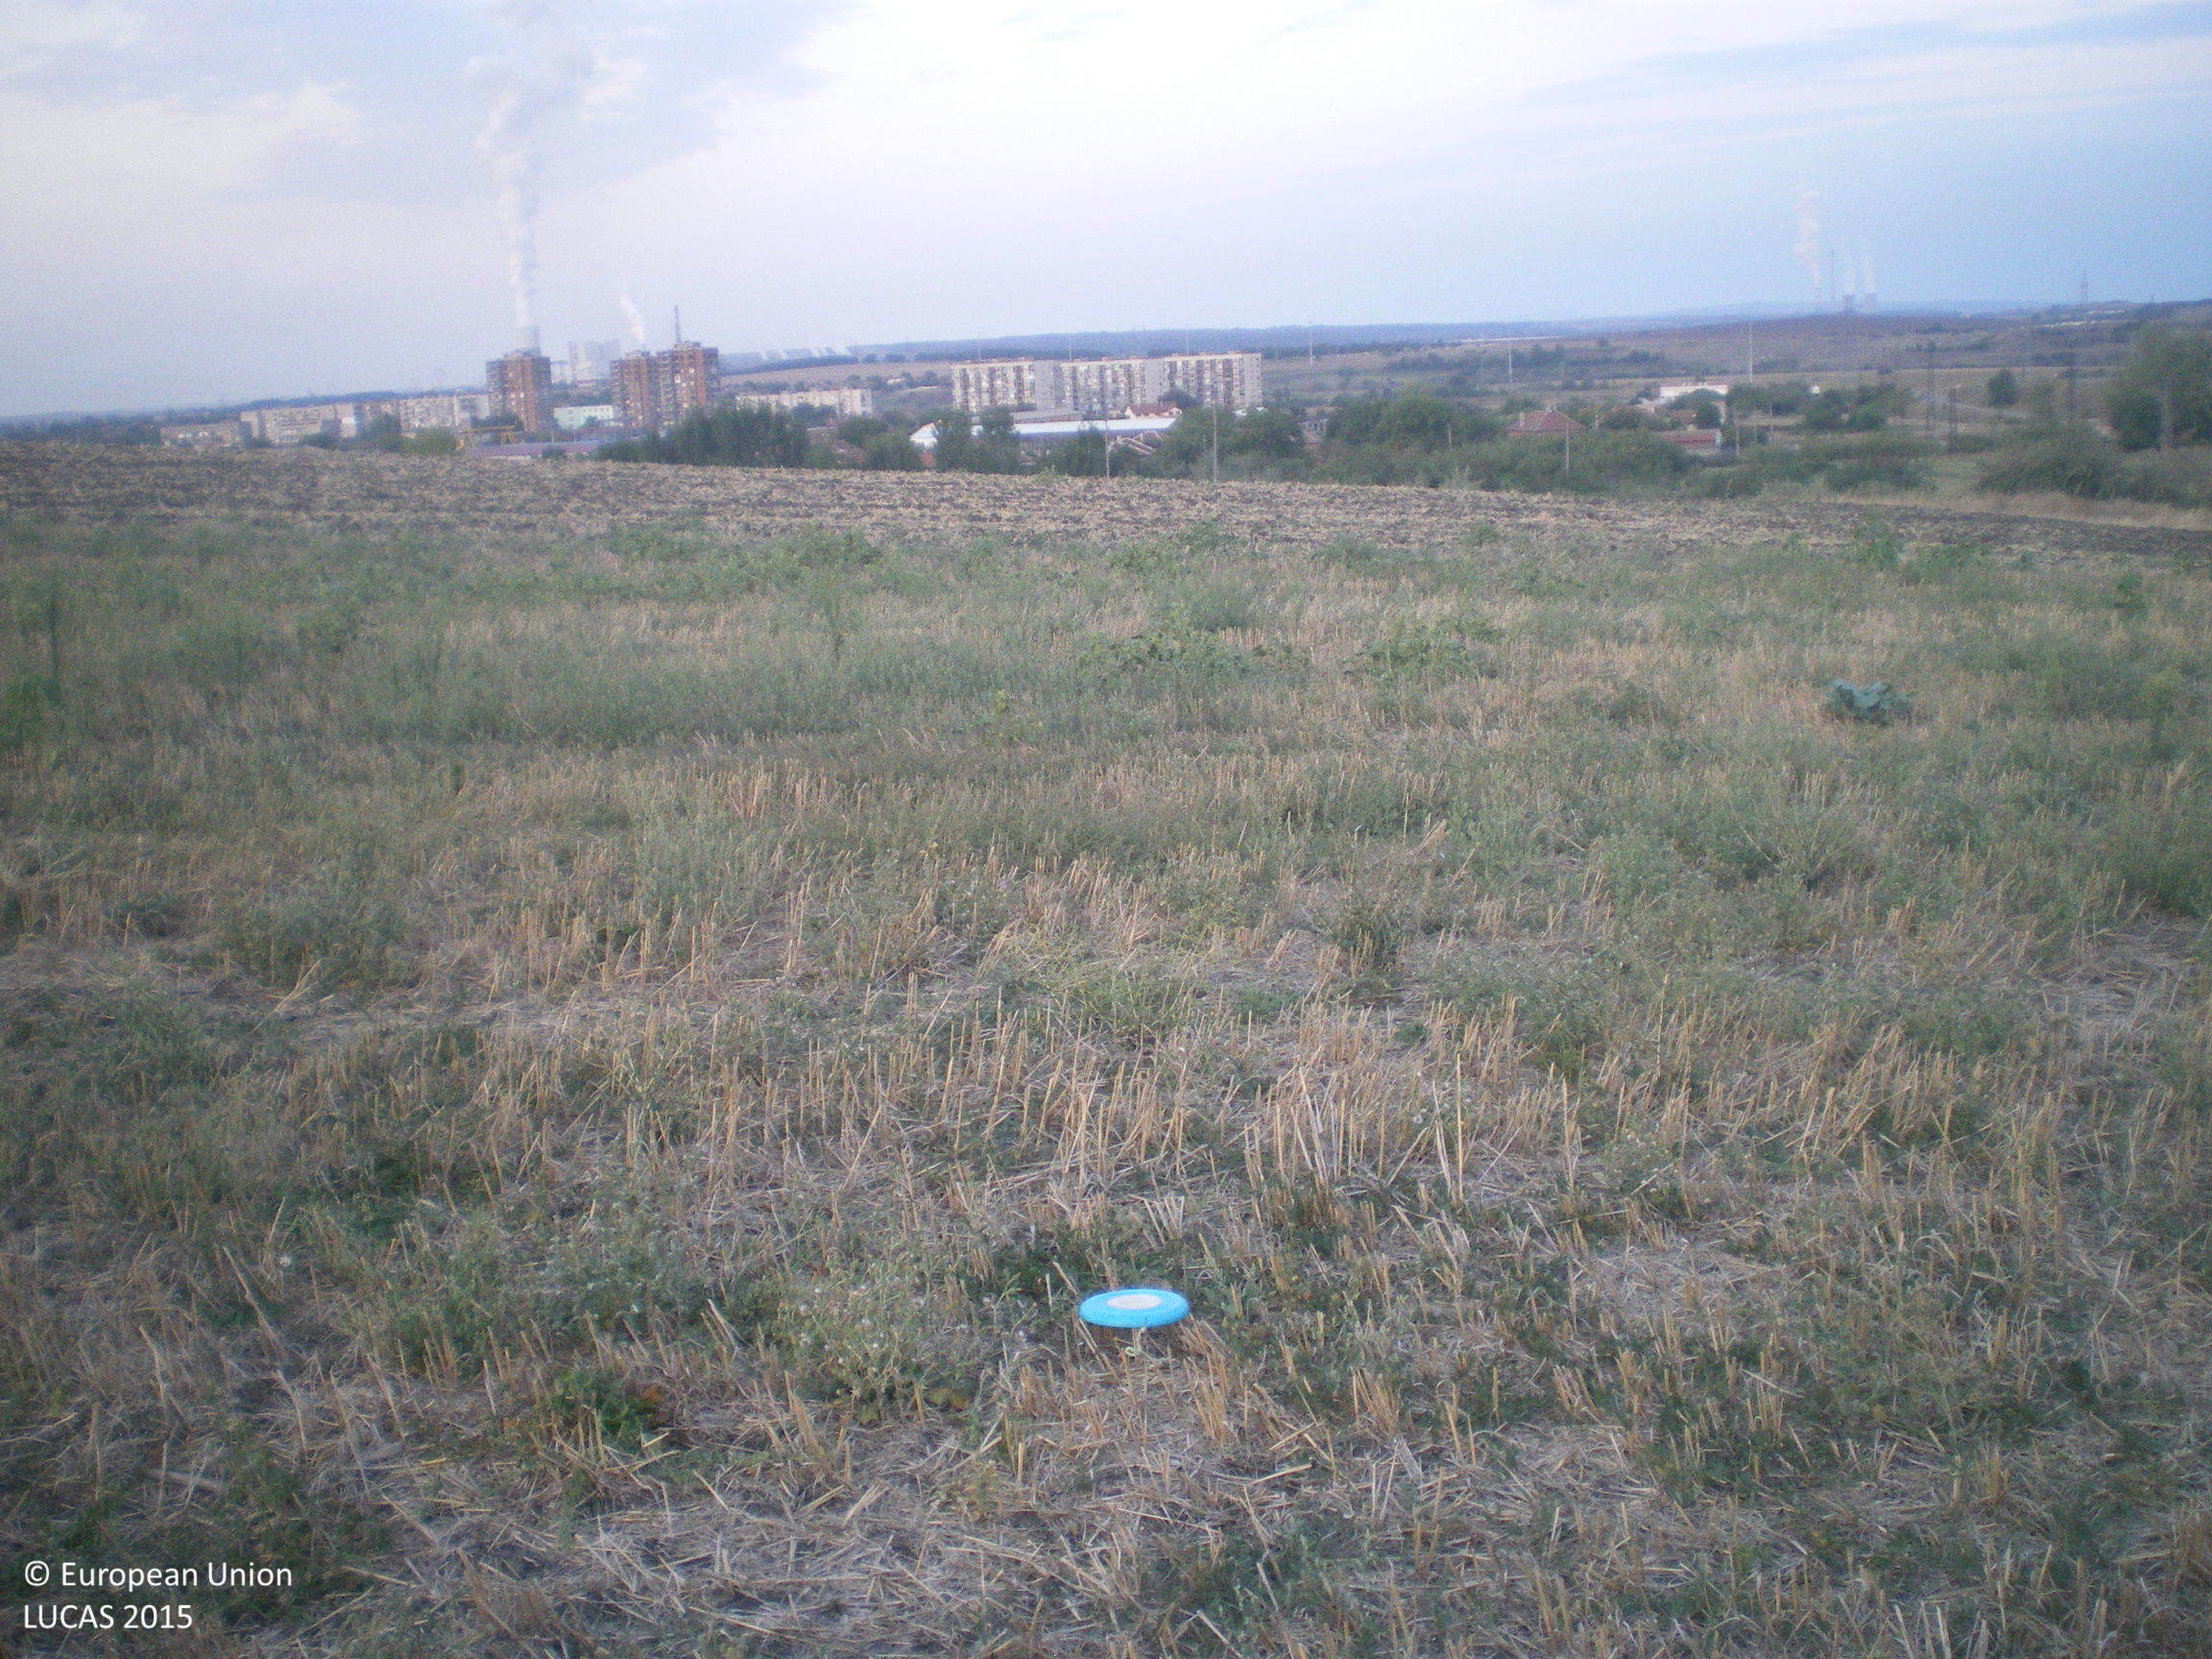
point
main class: Cropland
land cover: Common wheat
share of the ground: < 10 %
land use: Agriculture (excluding fallow land and kitchen gardens)
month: September
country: BG
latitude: 42.1299
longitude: 25.8603
